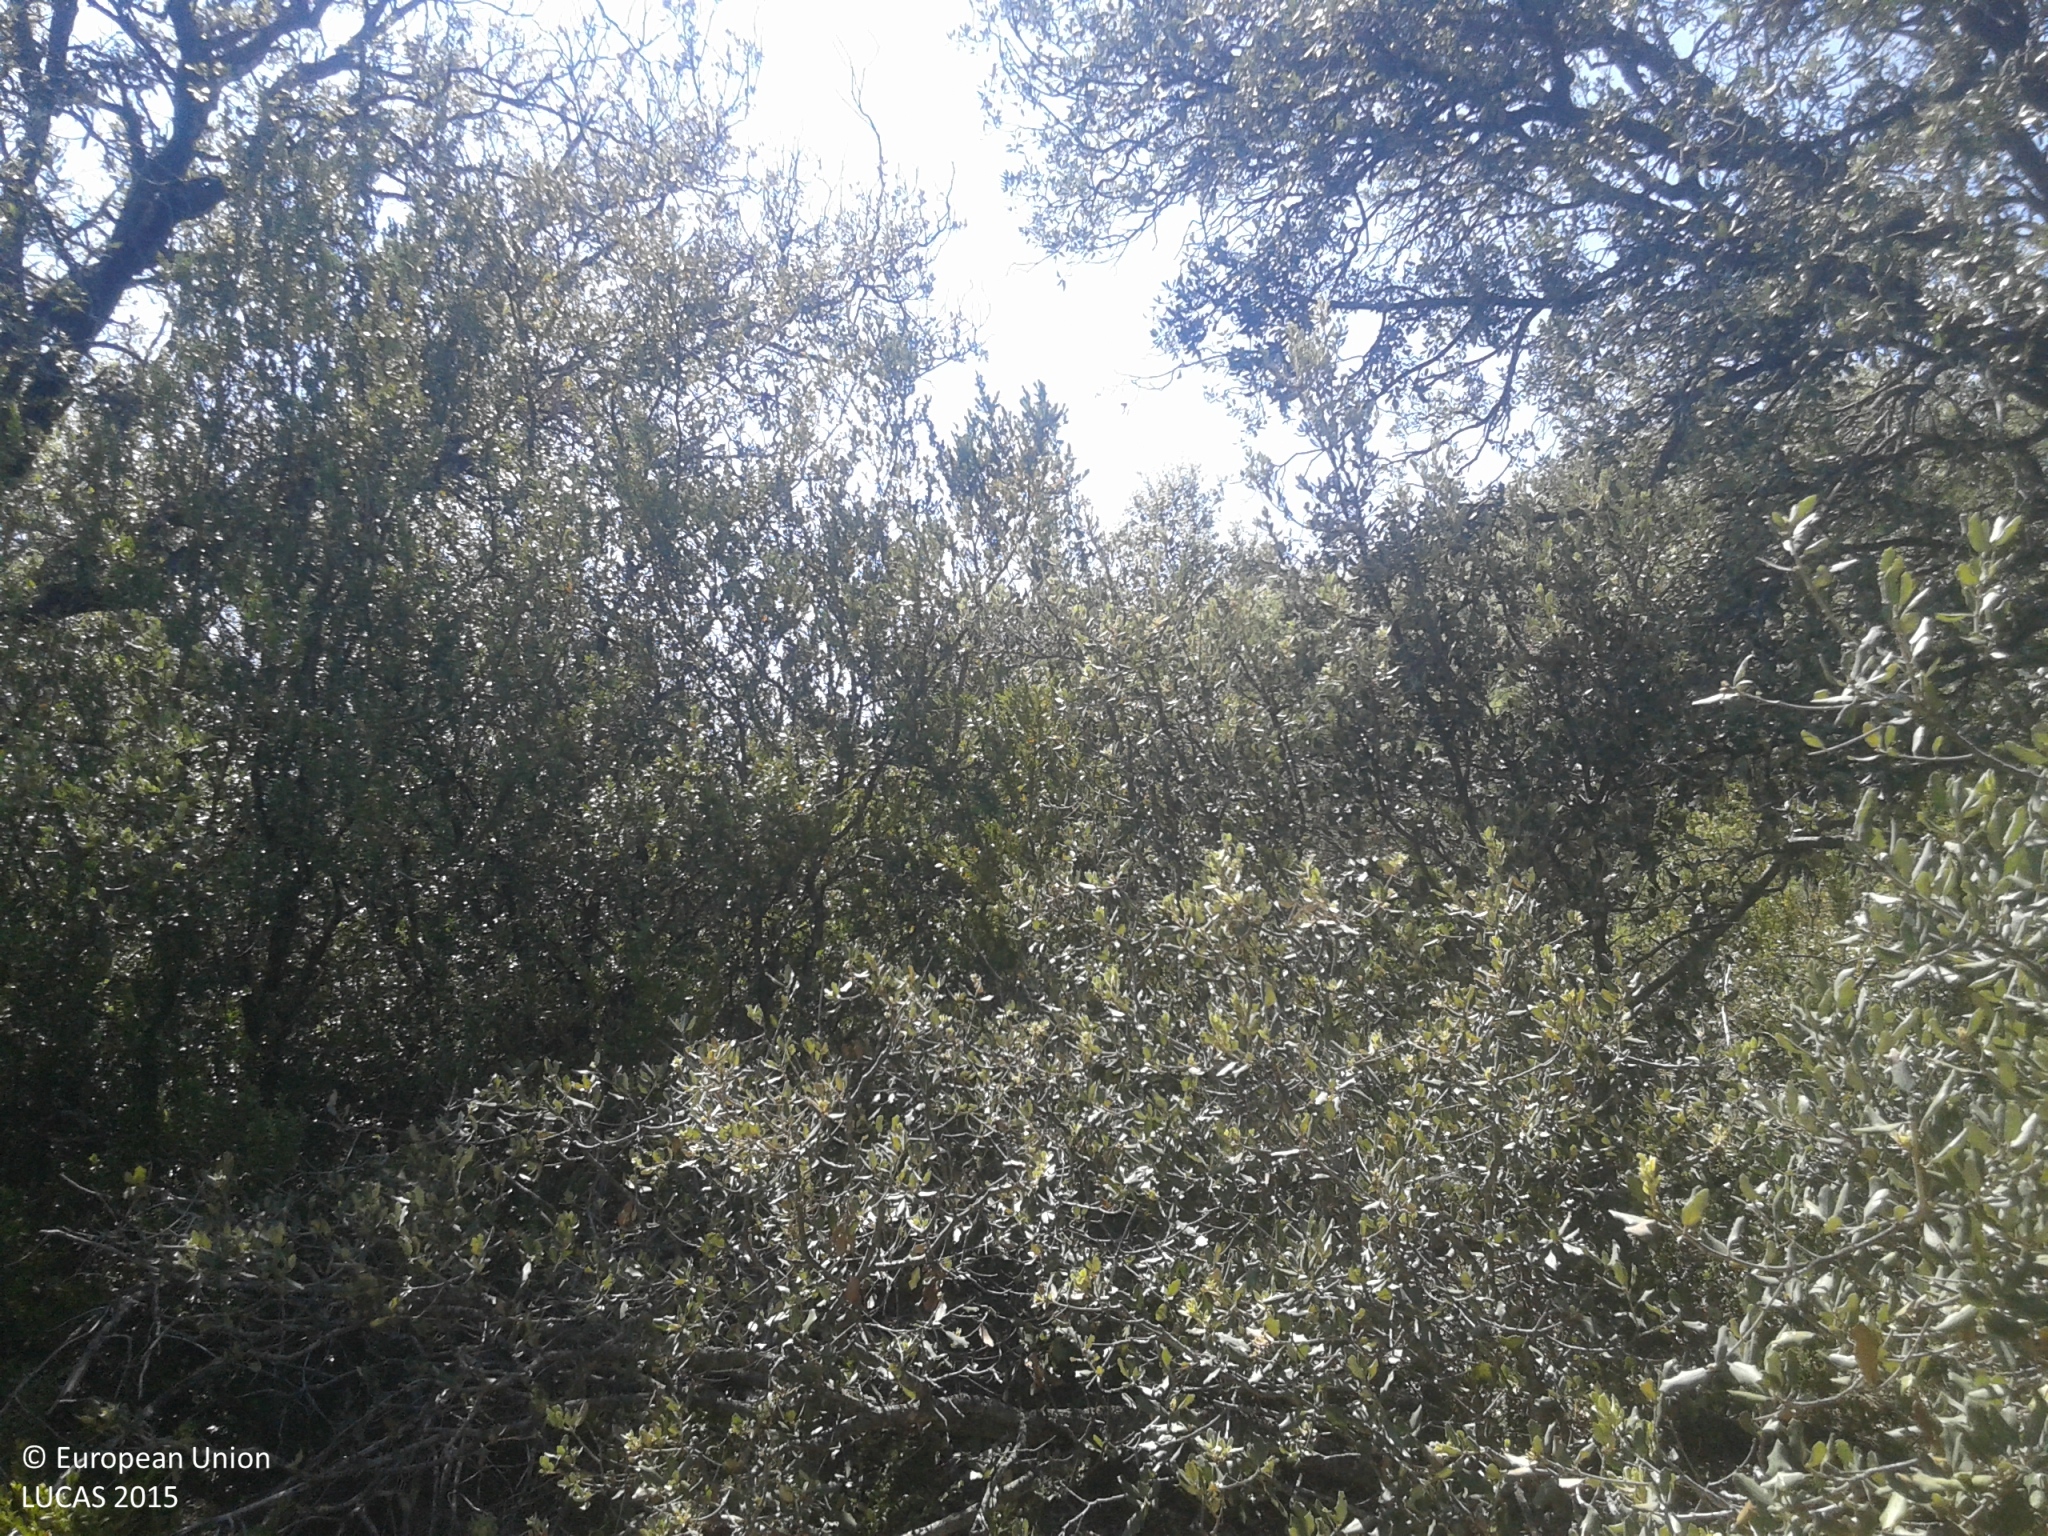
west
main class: Woodland
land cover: Broadleaved woodland
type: broadleaved evergreen forest
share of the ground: 50 - 75 %
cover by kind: broadleaved forest trees 70 %, shrubs 20 %, herbaceous plants 10 %
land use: Semi-natural and natural areas not in use
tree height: > 5 m
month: July
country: ES
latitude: 42.0822
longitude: 1.1256
